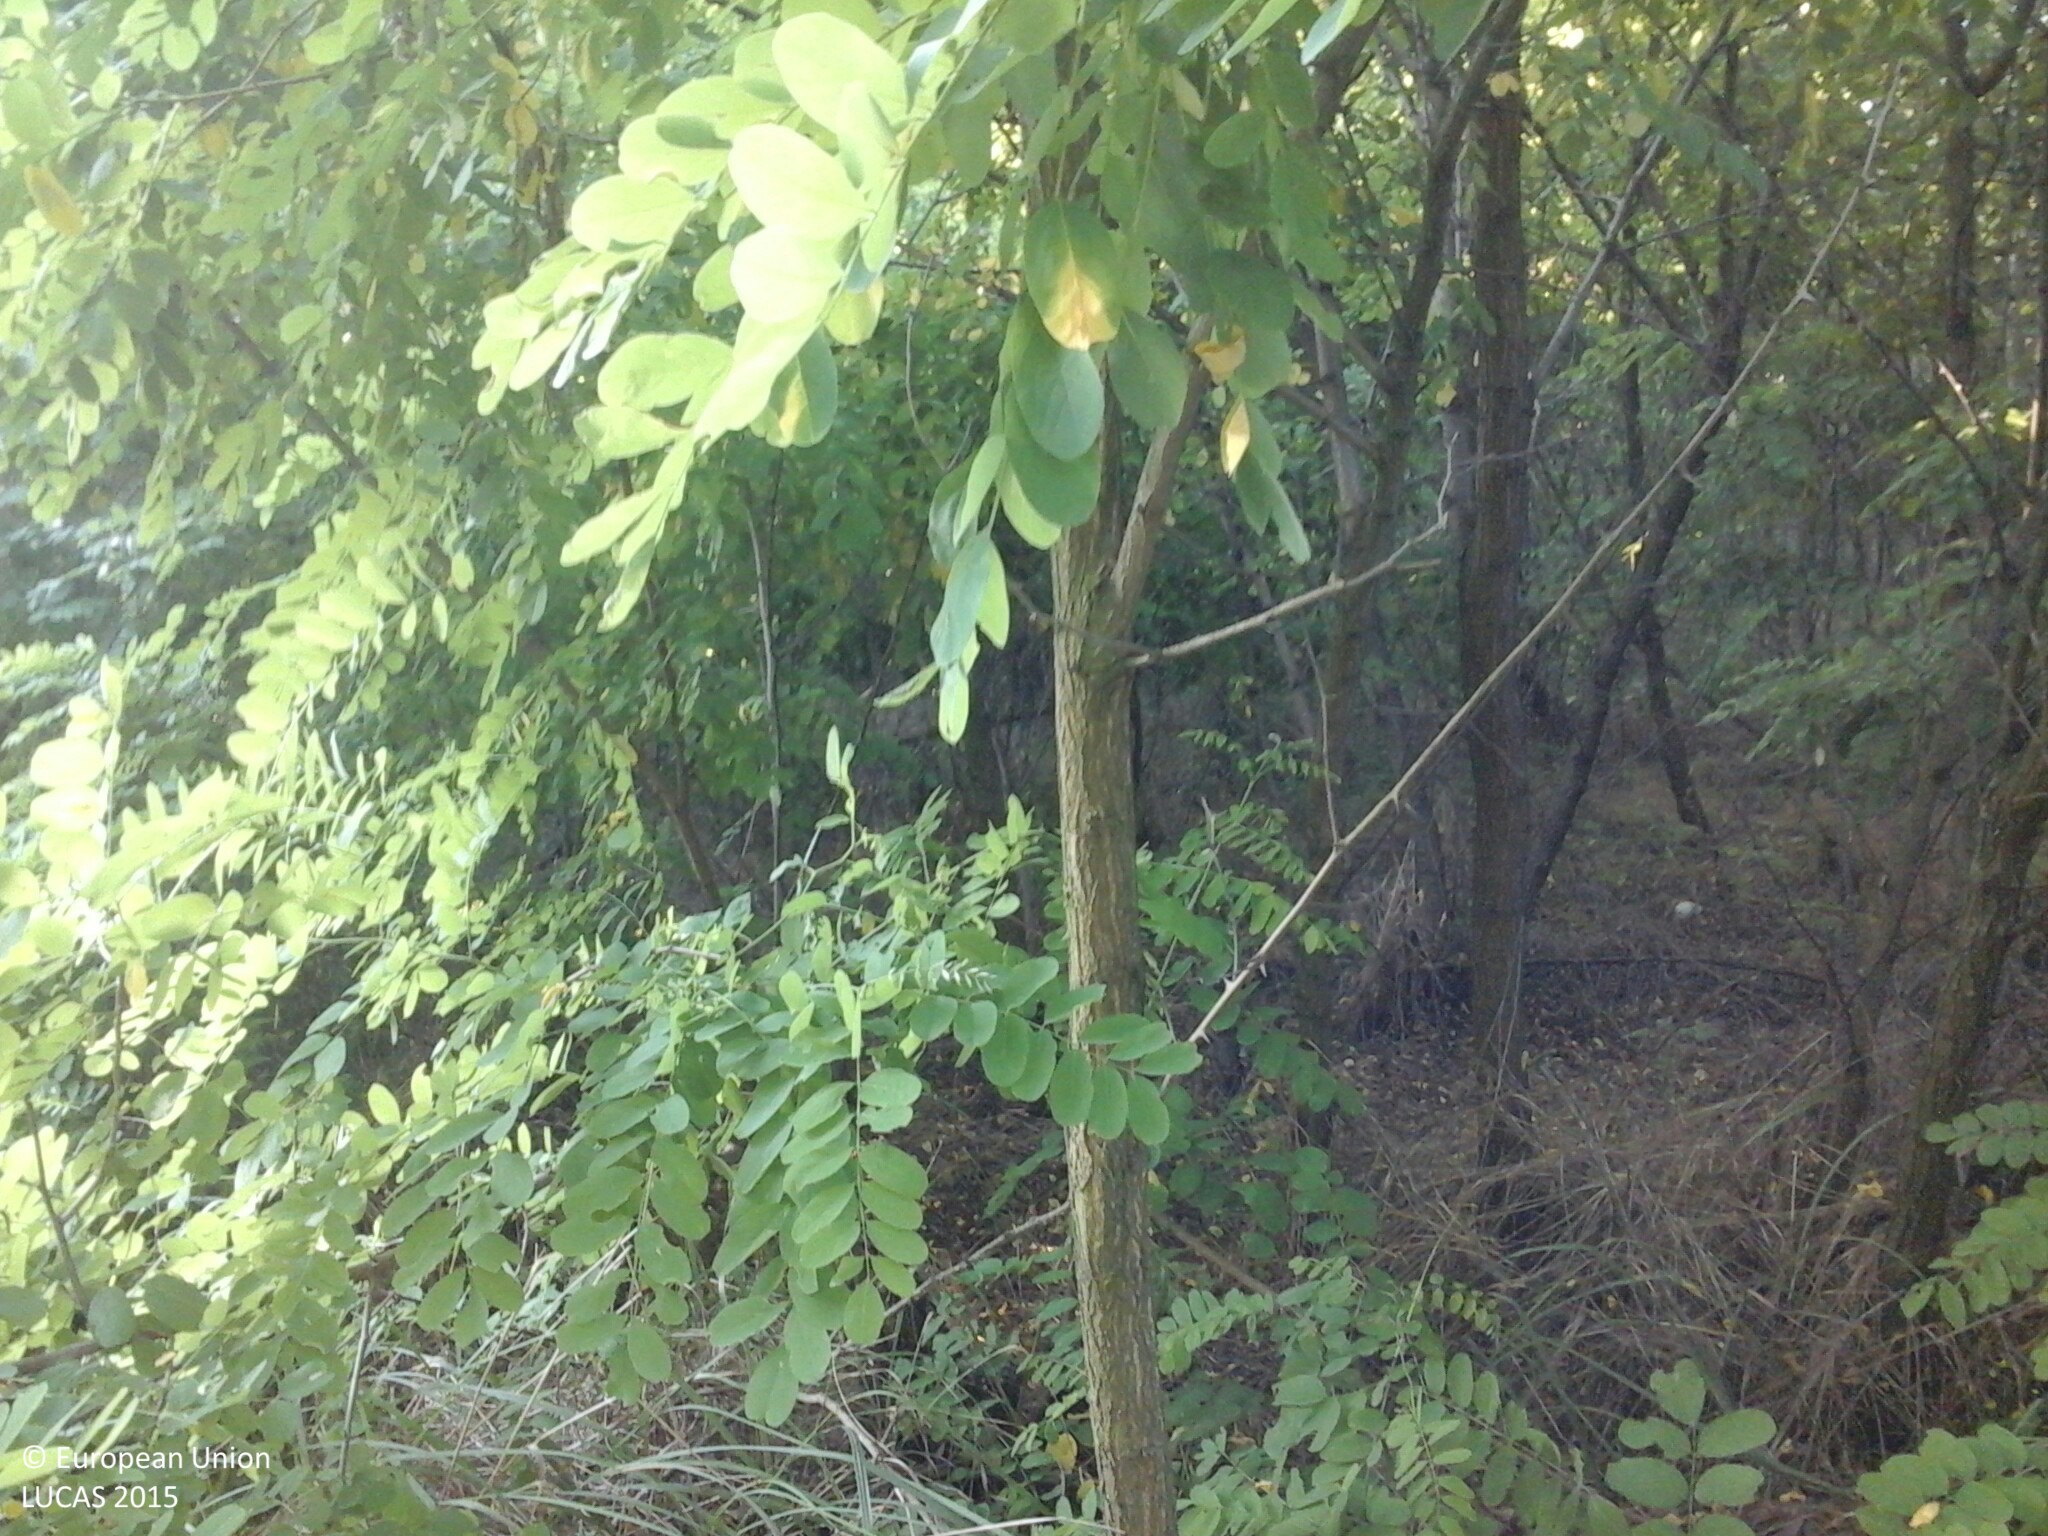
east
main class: Woodland
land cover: Broadleaved woodland
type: mesophytic deciduous forest
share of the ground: > 75 %
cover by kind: broadleaved forest trees 90 %, herbaceous plants 10 %
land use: Forestry
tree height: > 5 m
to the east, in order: Broadleaved woodland
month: July
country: HU
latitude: 48.1797
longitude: 22.0367
